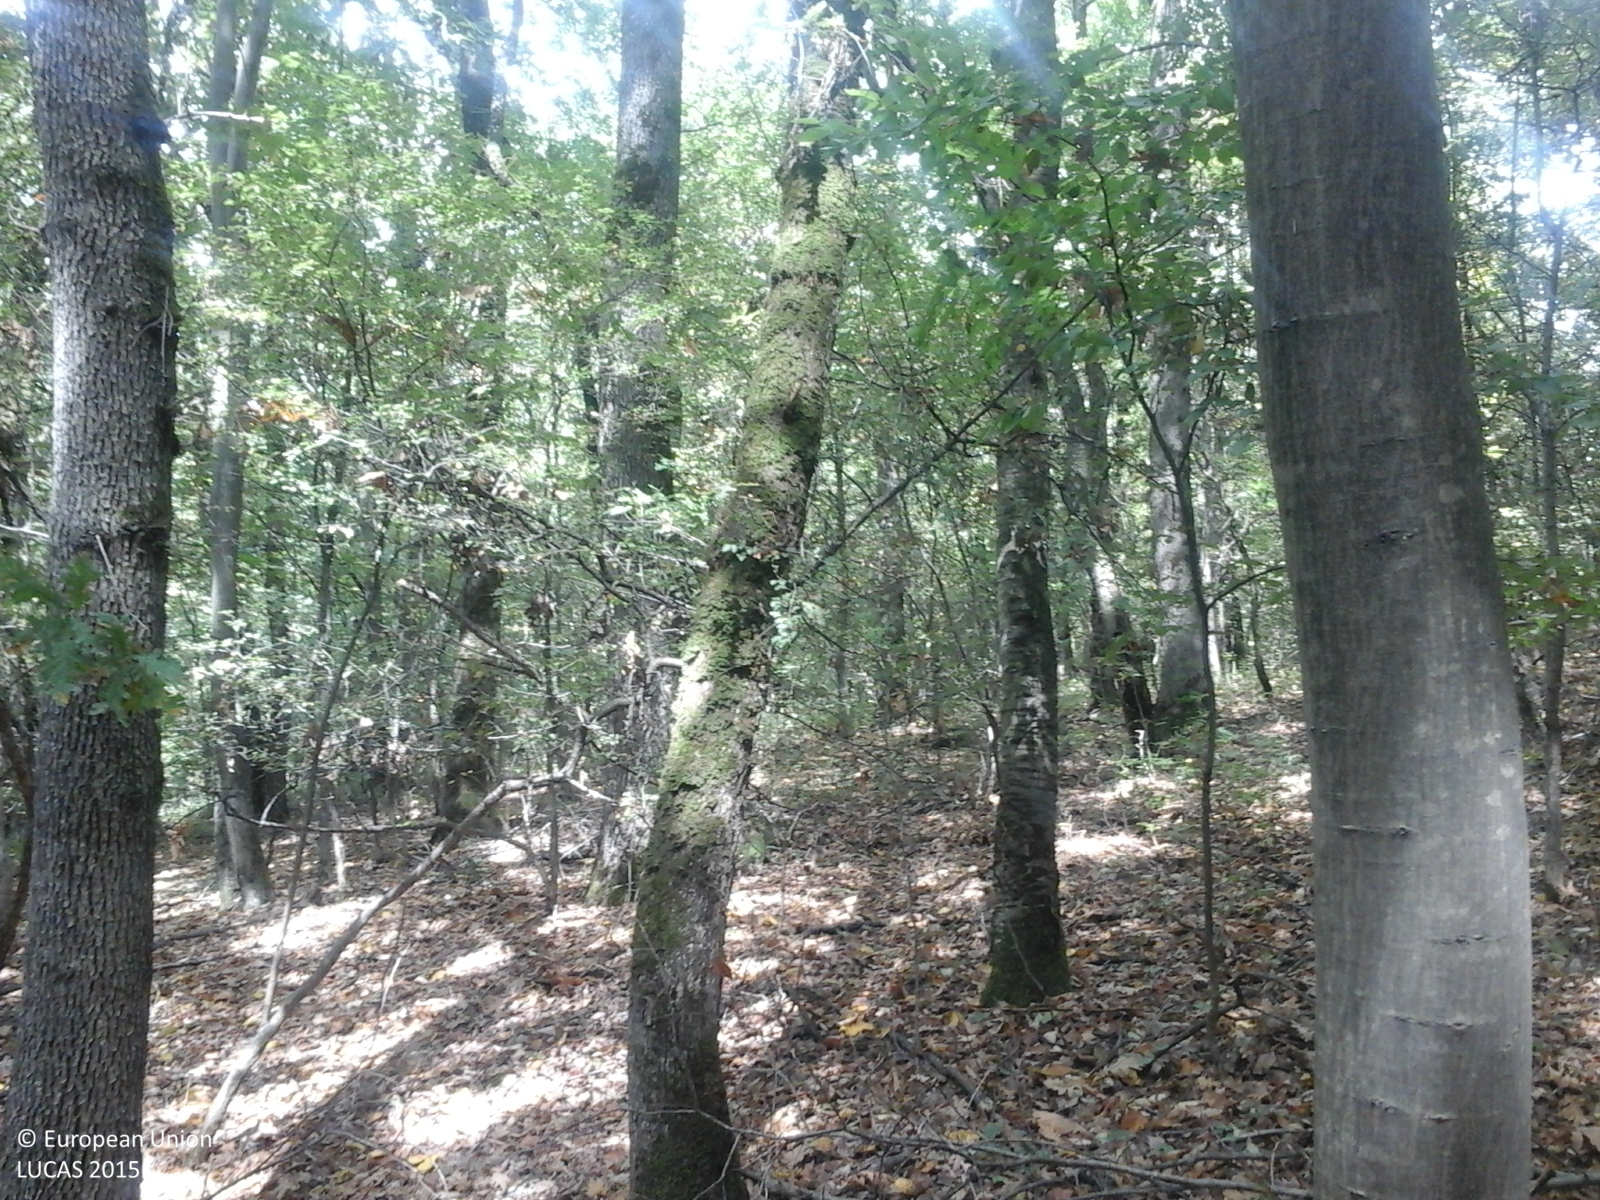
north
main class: Woodland
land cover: Broadleaved woodland
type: beech forest
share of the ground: > 75 %
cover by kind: broadleaved forest trees 100 %
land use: Forestry
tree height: > 5 m
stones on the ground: 10 - 25 %
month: August
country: RO
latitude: 45.2911
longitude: 21.6744
